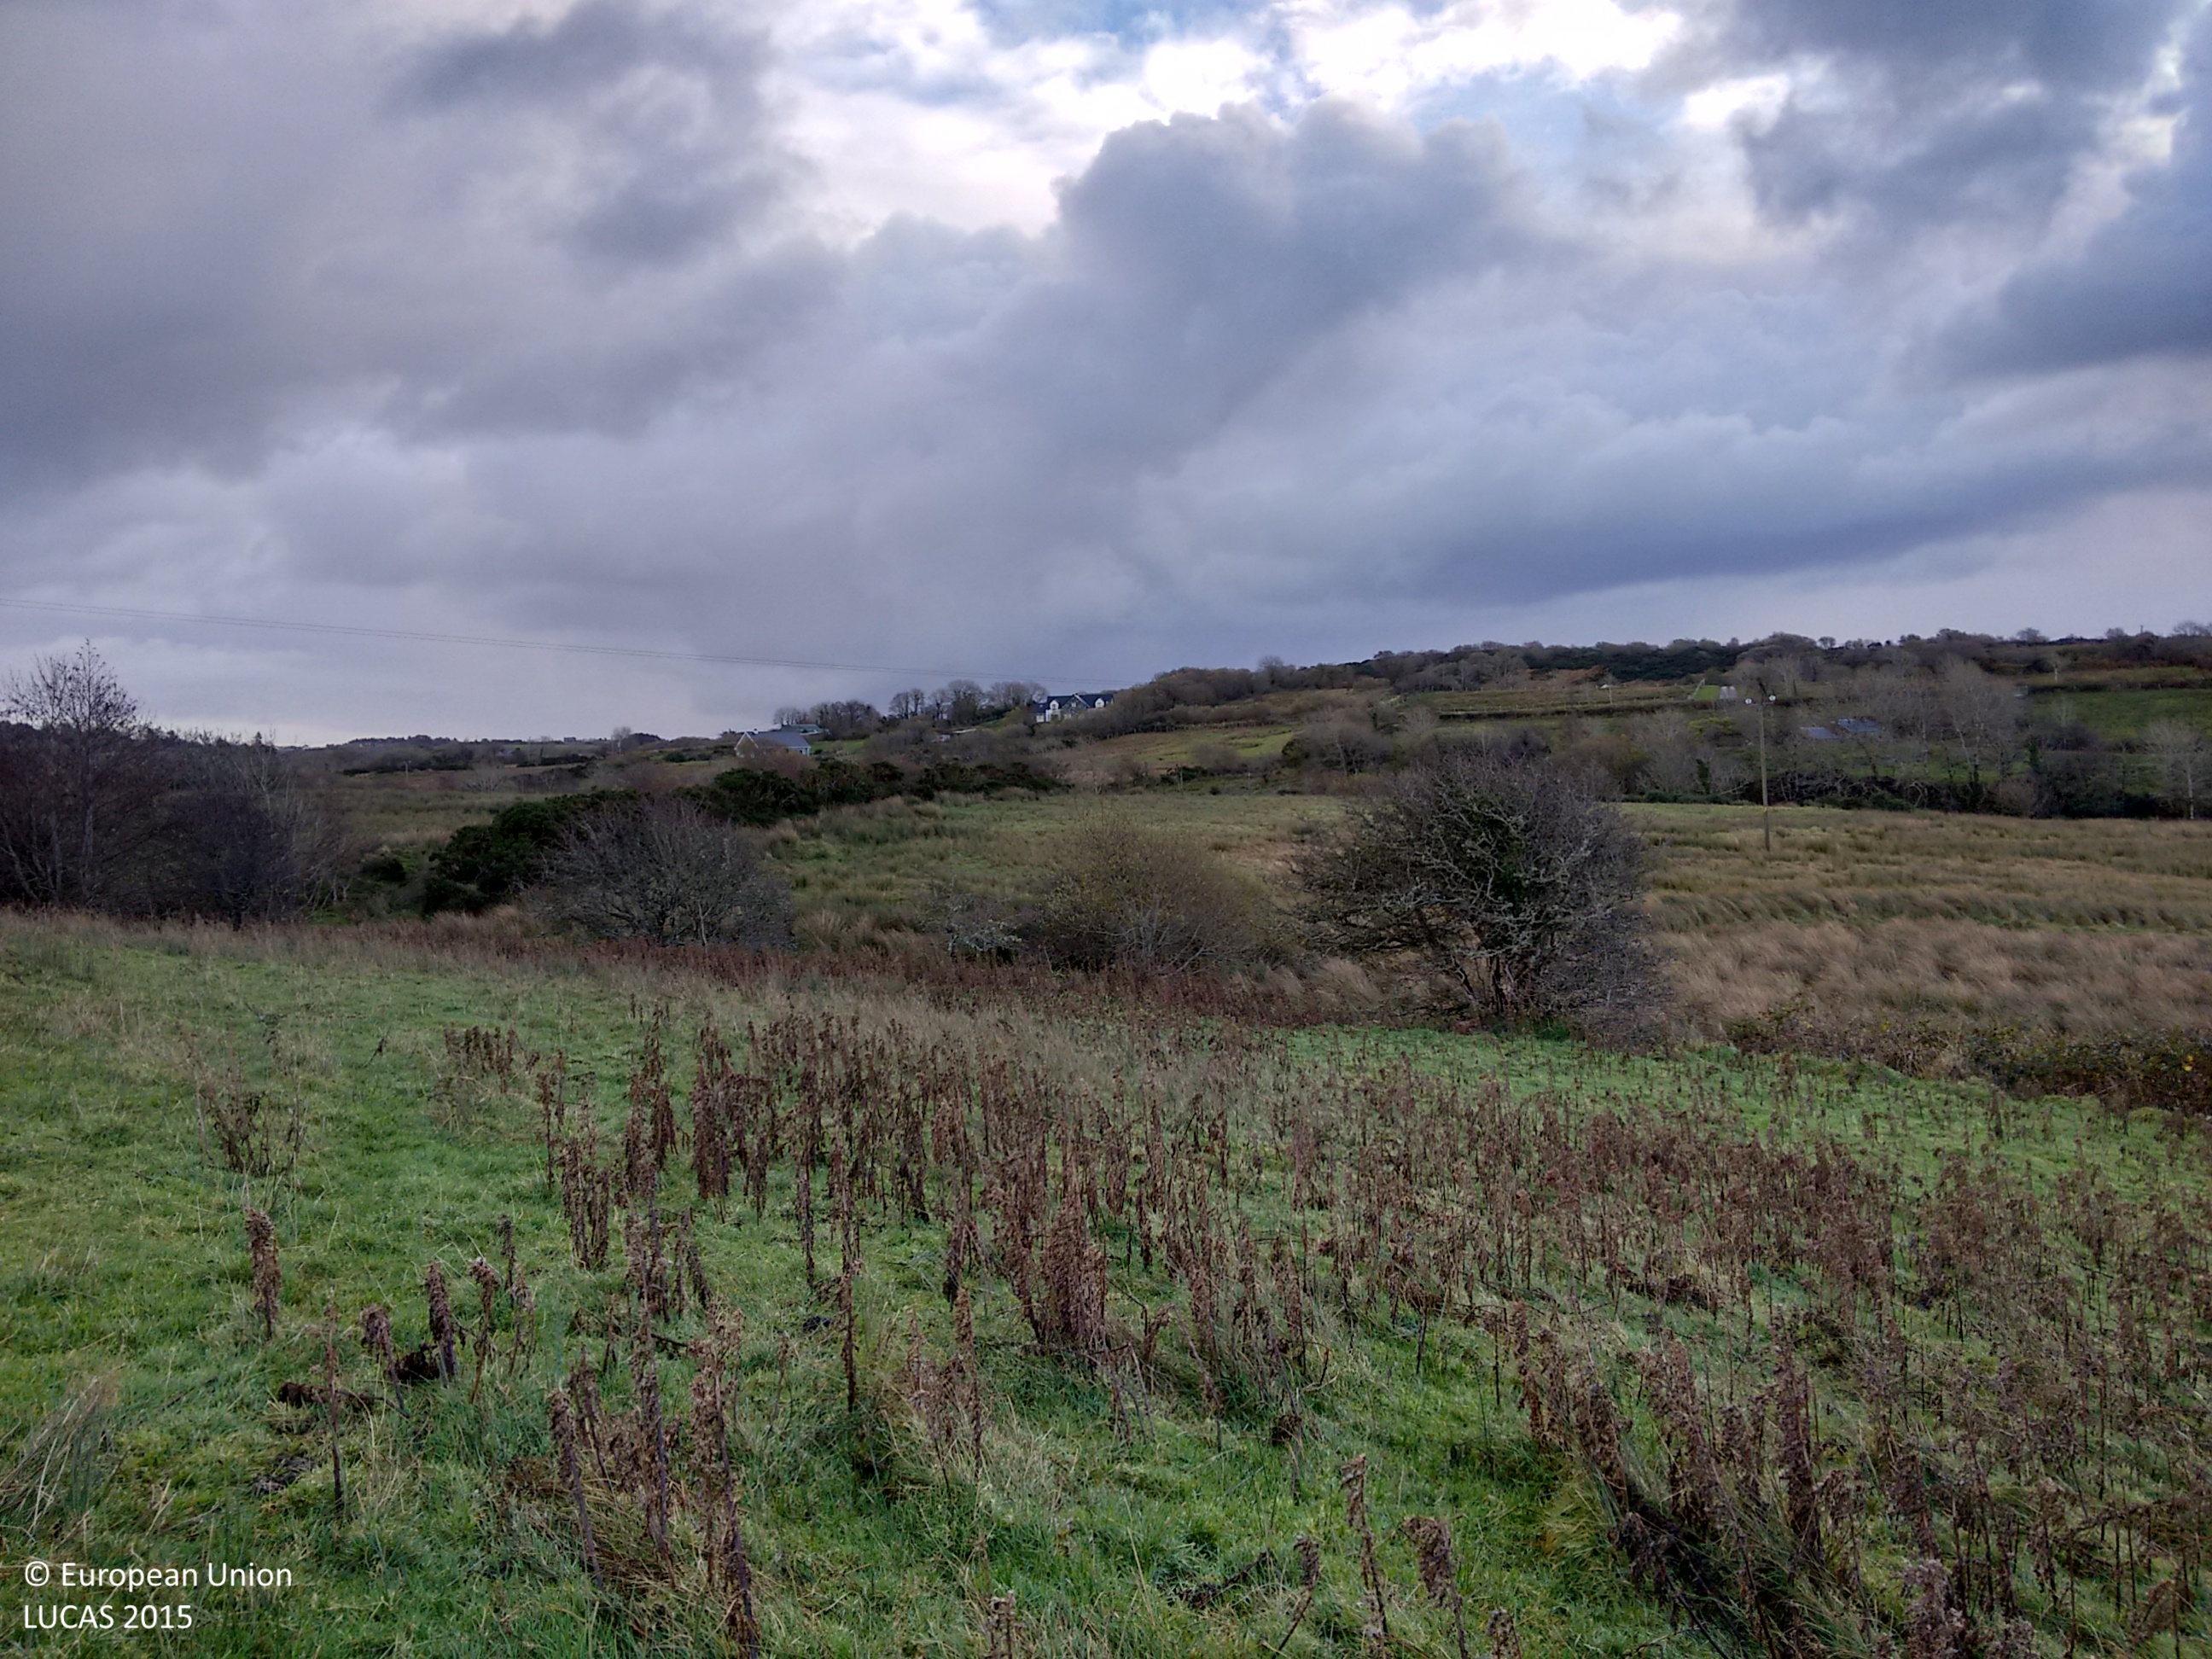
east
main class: Grassland
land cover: Grassland without tree/shrub cover
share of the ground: > 75 %
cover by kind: herbaceous plants 100 %
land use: Agriculture (excluding fallow land and kitchen gardens)
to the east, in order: Grassland without tree/shrub cover; Electric lines; Grassland without tree/shrub cover; Fences; Abandoned hedges; Grassland without tree/shrub cover; Electric lines; Grassland without tree/shrub cover; Fences; Abandoned hedges; Fences; Grassland without tree/shrub cover; Fences; Lines of trees; Rivers and streams; Grassland without tree/shrub cover; Fences; Shruby margins; Ditches and canals; Lines of trees; Fences; Grassland without tree/shrub cover
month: November
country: IE
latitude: 54.6373
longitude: -8.2628
